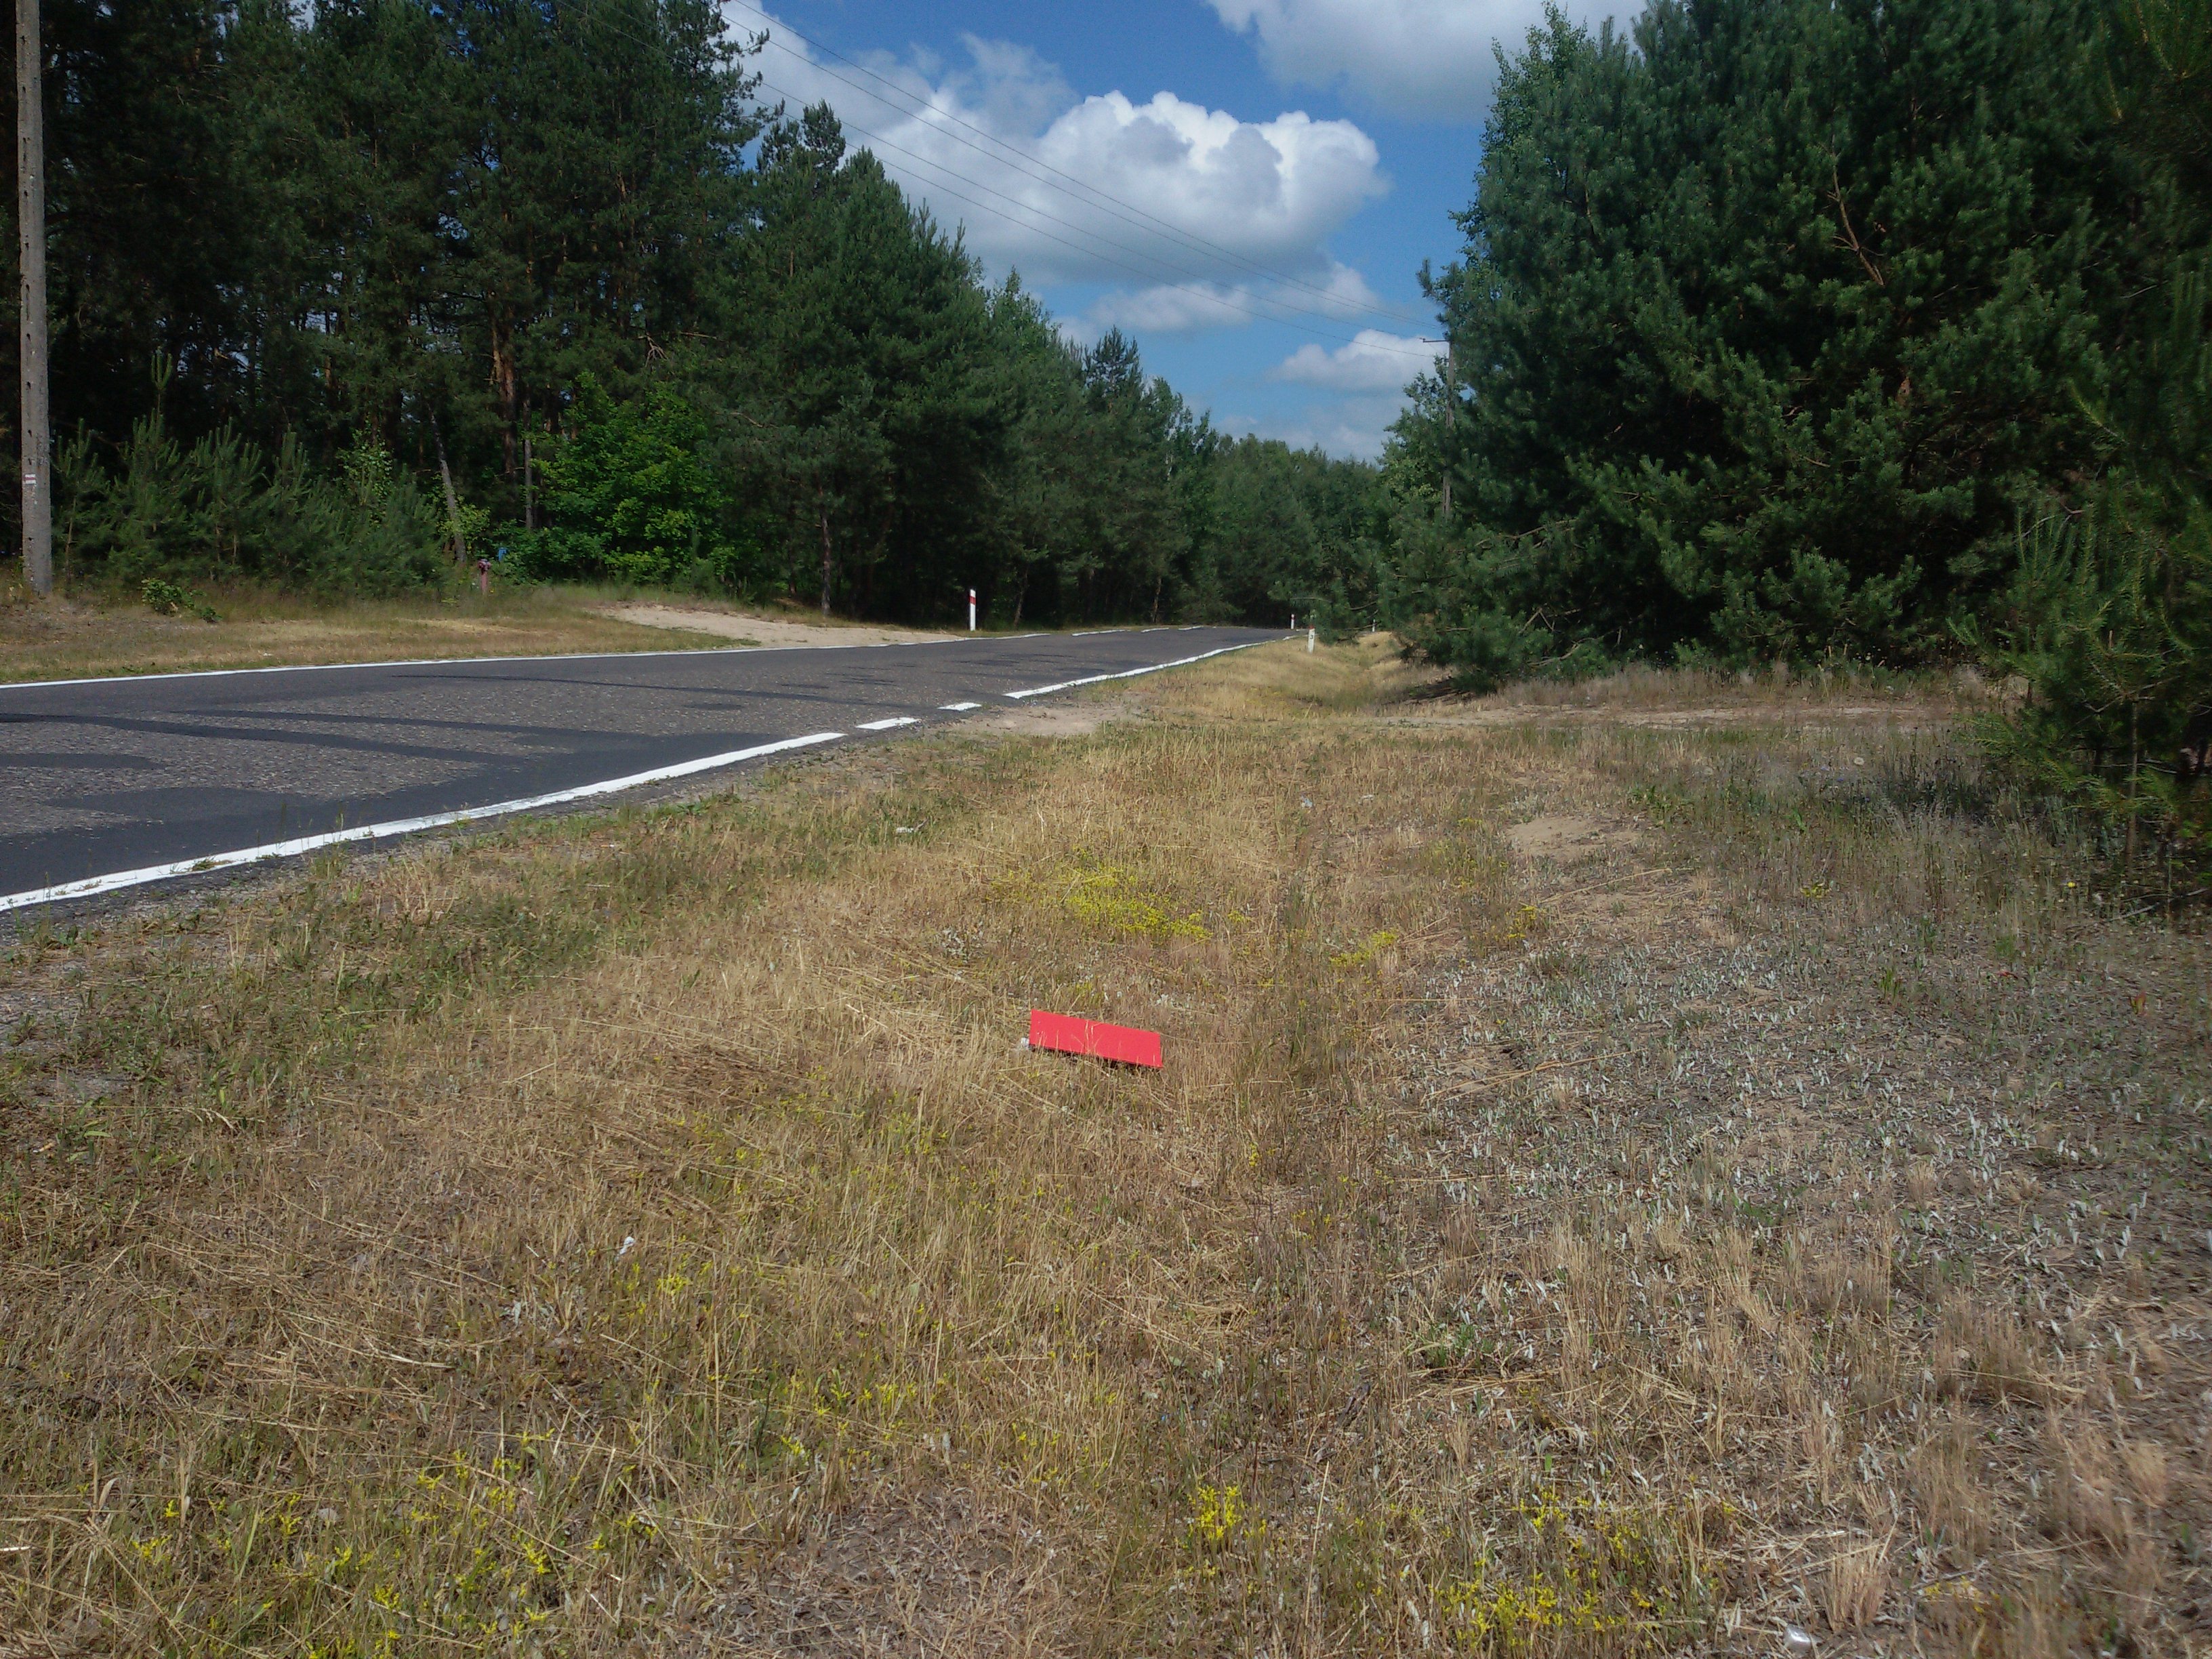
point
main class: Woodland
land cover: Spruce dominated coniferous woodland
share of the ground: > 75 %
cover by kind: coniferous forest trees 95 %, herbaceous plants 5 %
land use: Forestry
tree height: < 5 m
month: June
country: PL
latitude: 51.8277
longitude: 23.5952
